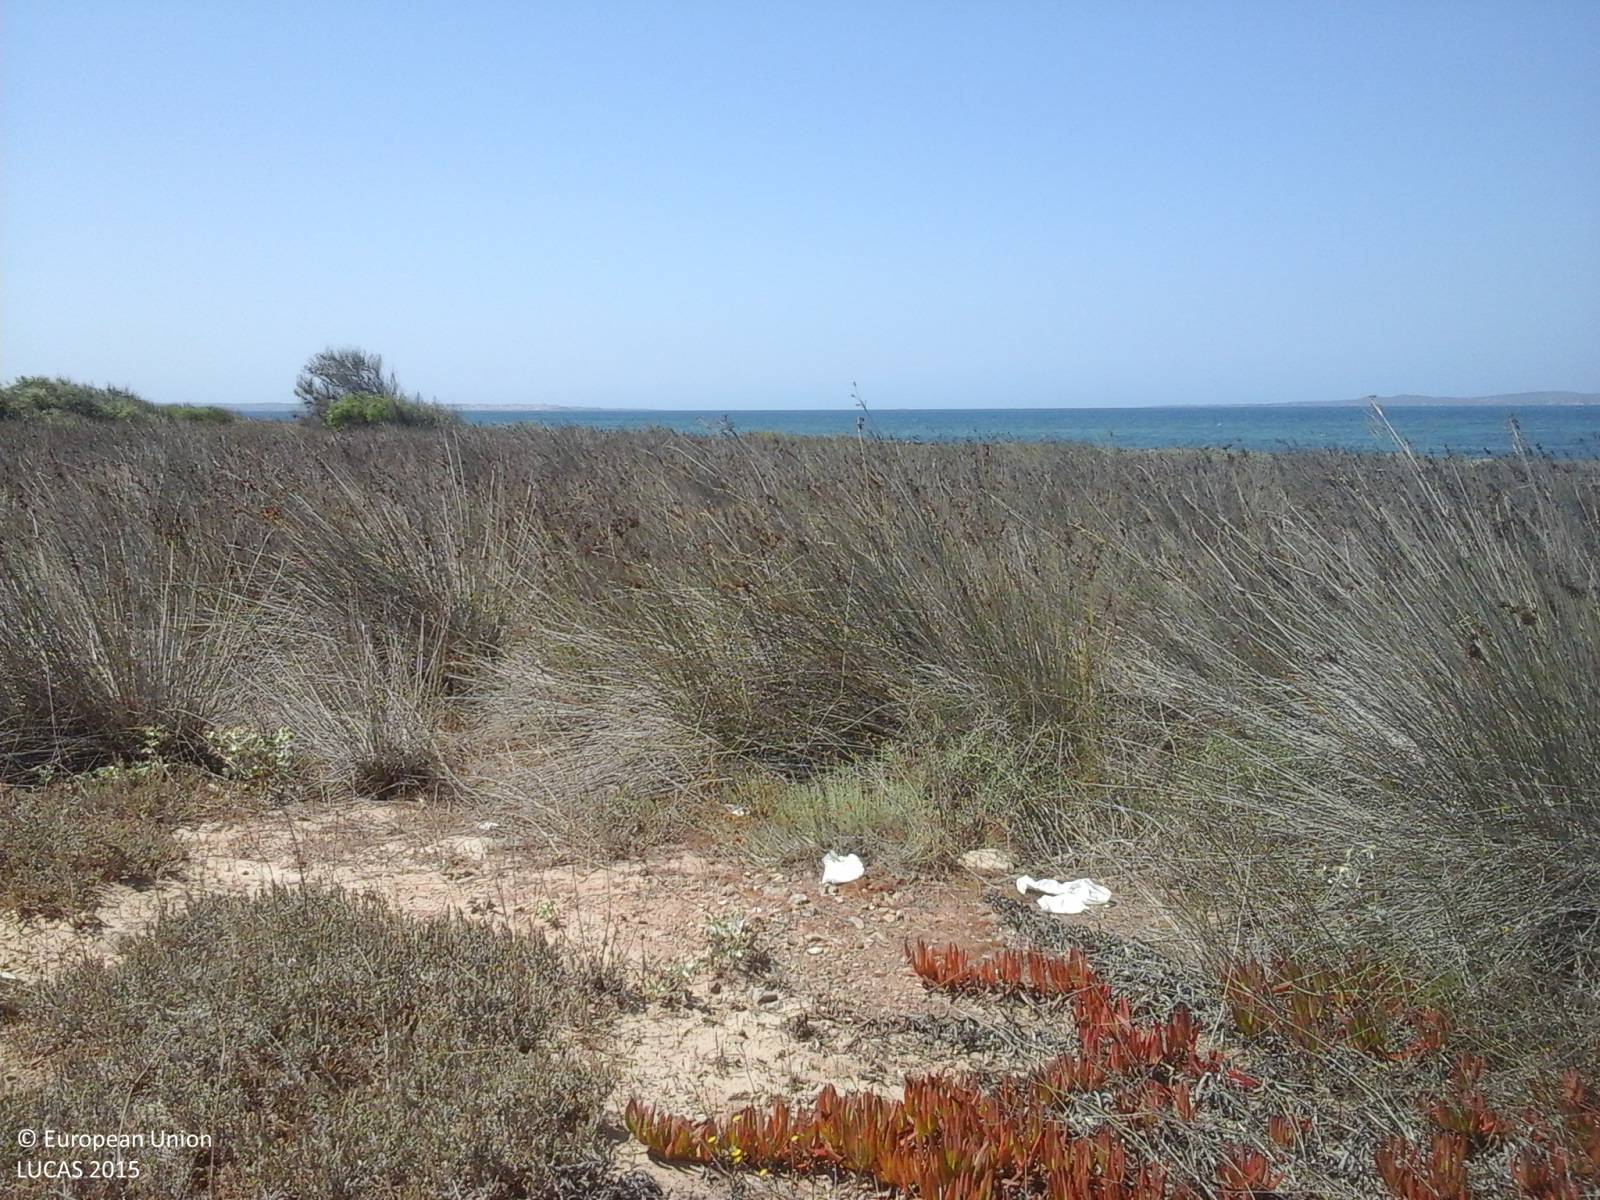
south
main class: Grassland
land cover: Grassland without tree/shrub cover
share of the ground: > 75 %
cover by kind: herbaceous plants 50 %, unconsolidated bare surface 45 %, consolidated bare surface 5 %
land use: Semi-natural and natural areas not in use
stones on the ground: < 10 %
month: July
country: IT
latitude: 39.1855
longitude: 8.4007
